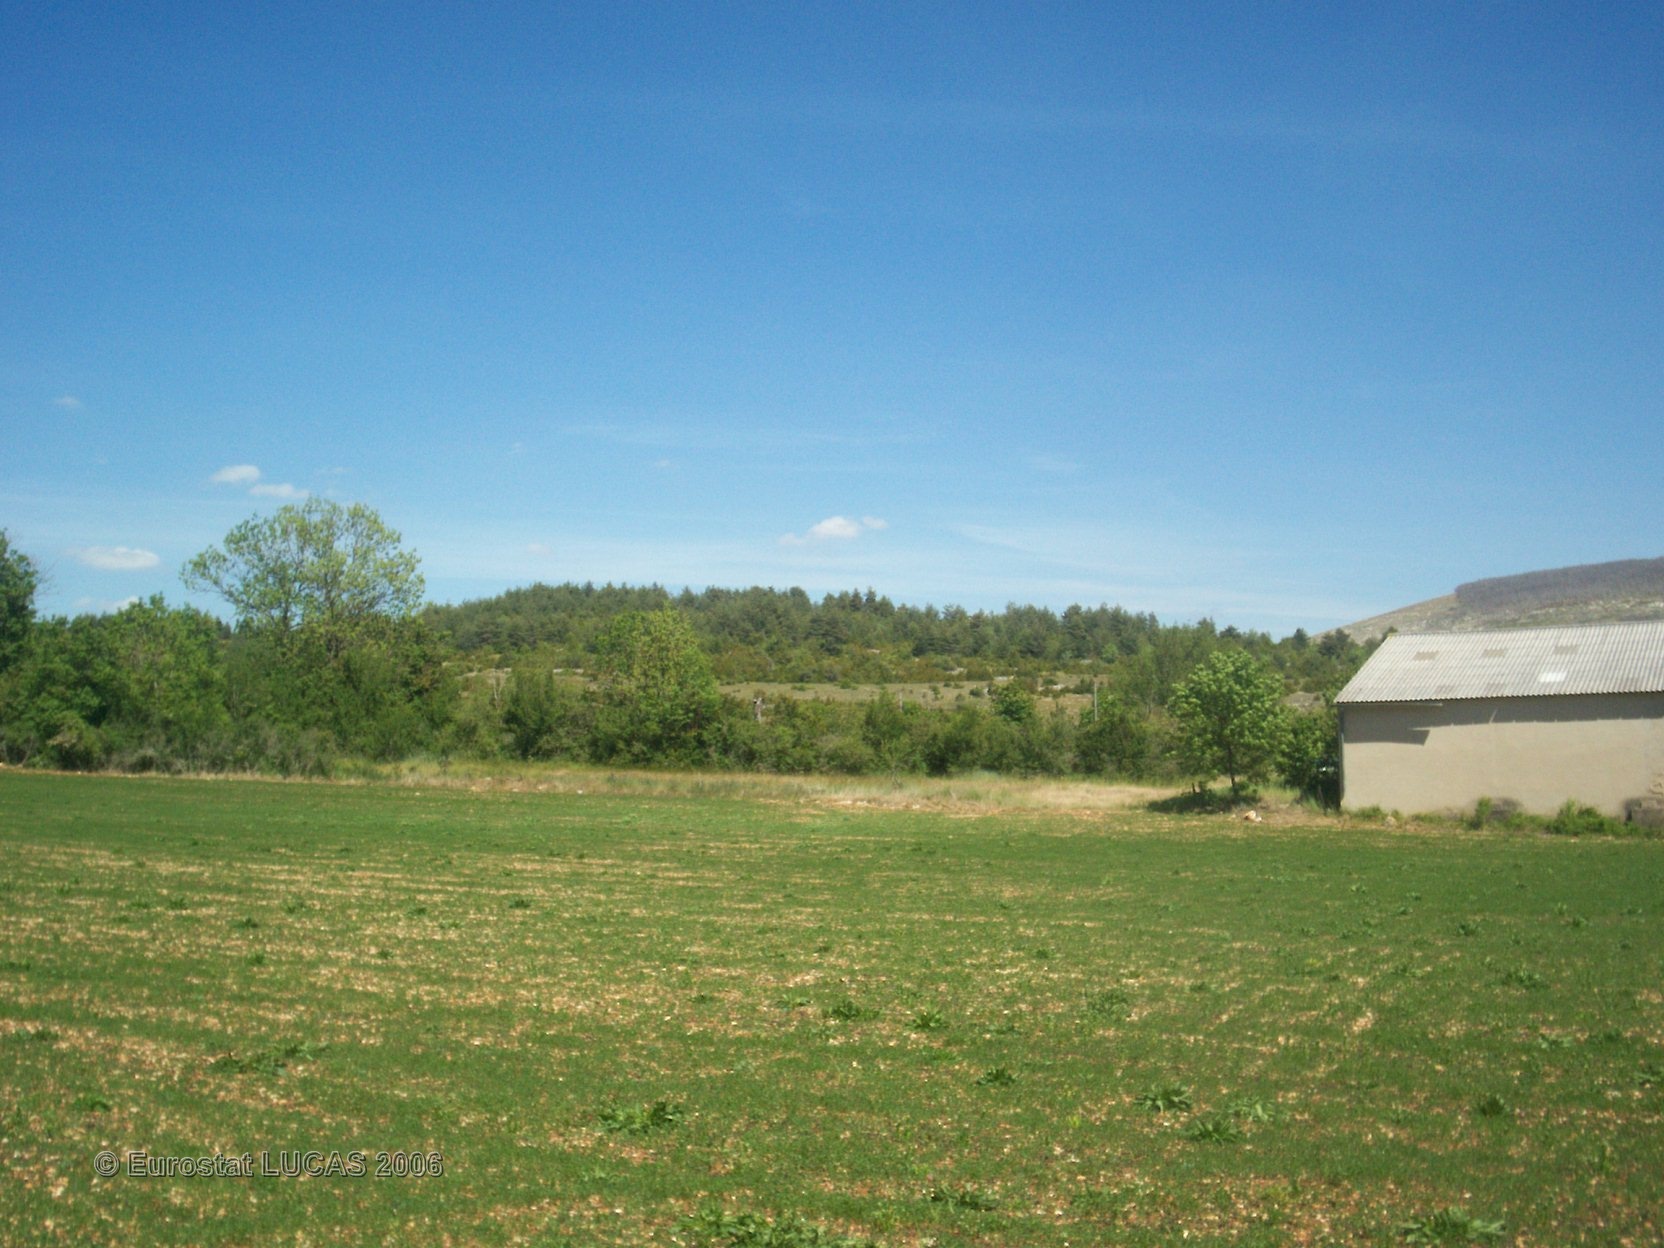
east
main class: Cropland
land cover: Clovers
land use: Agriculture (excluding fallow land and kitchen gardens)
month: June
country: FR
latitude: 44.3000
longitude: 3.3500
